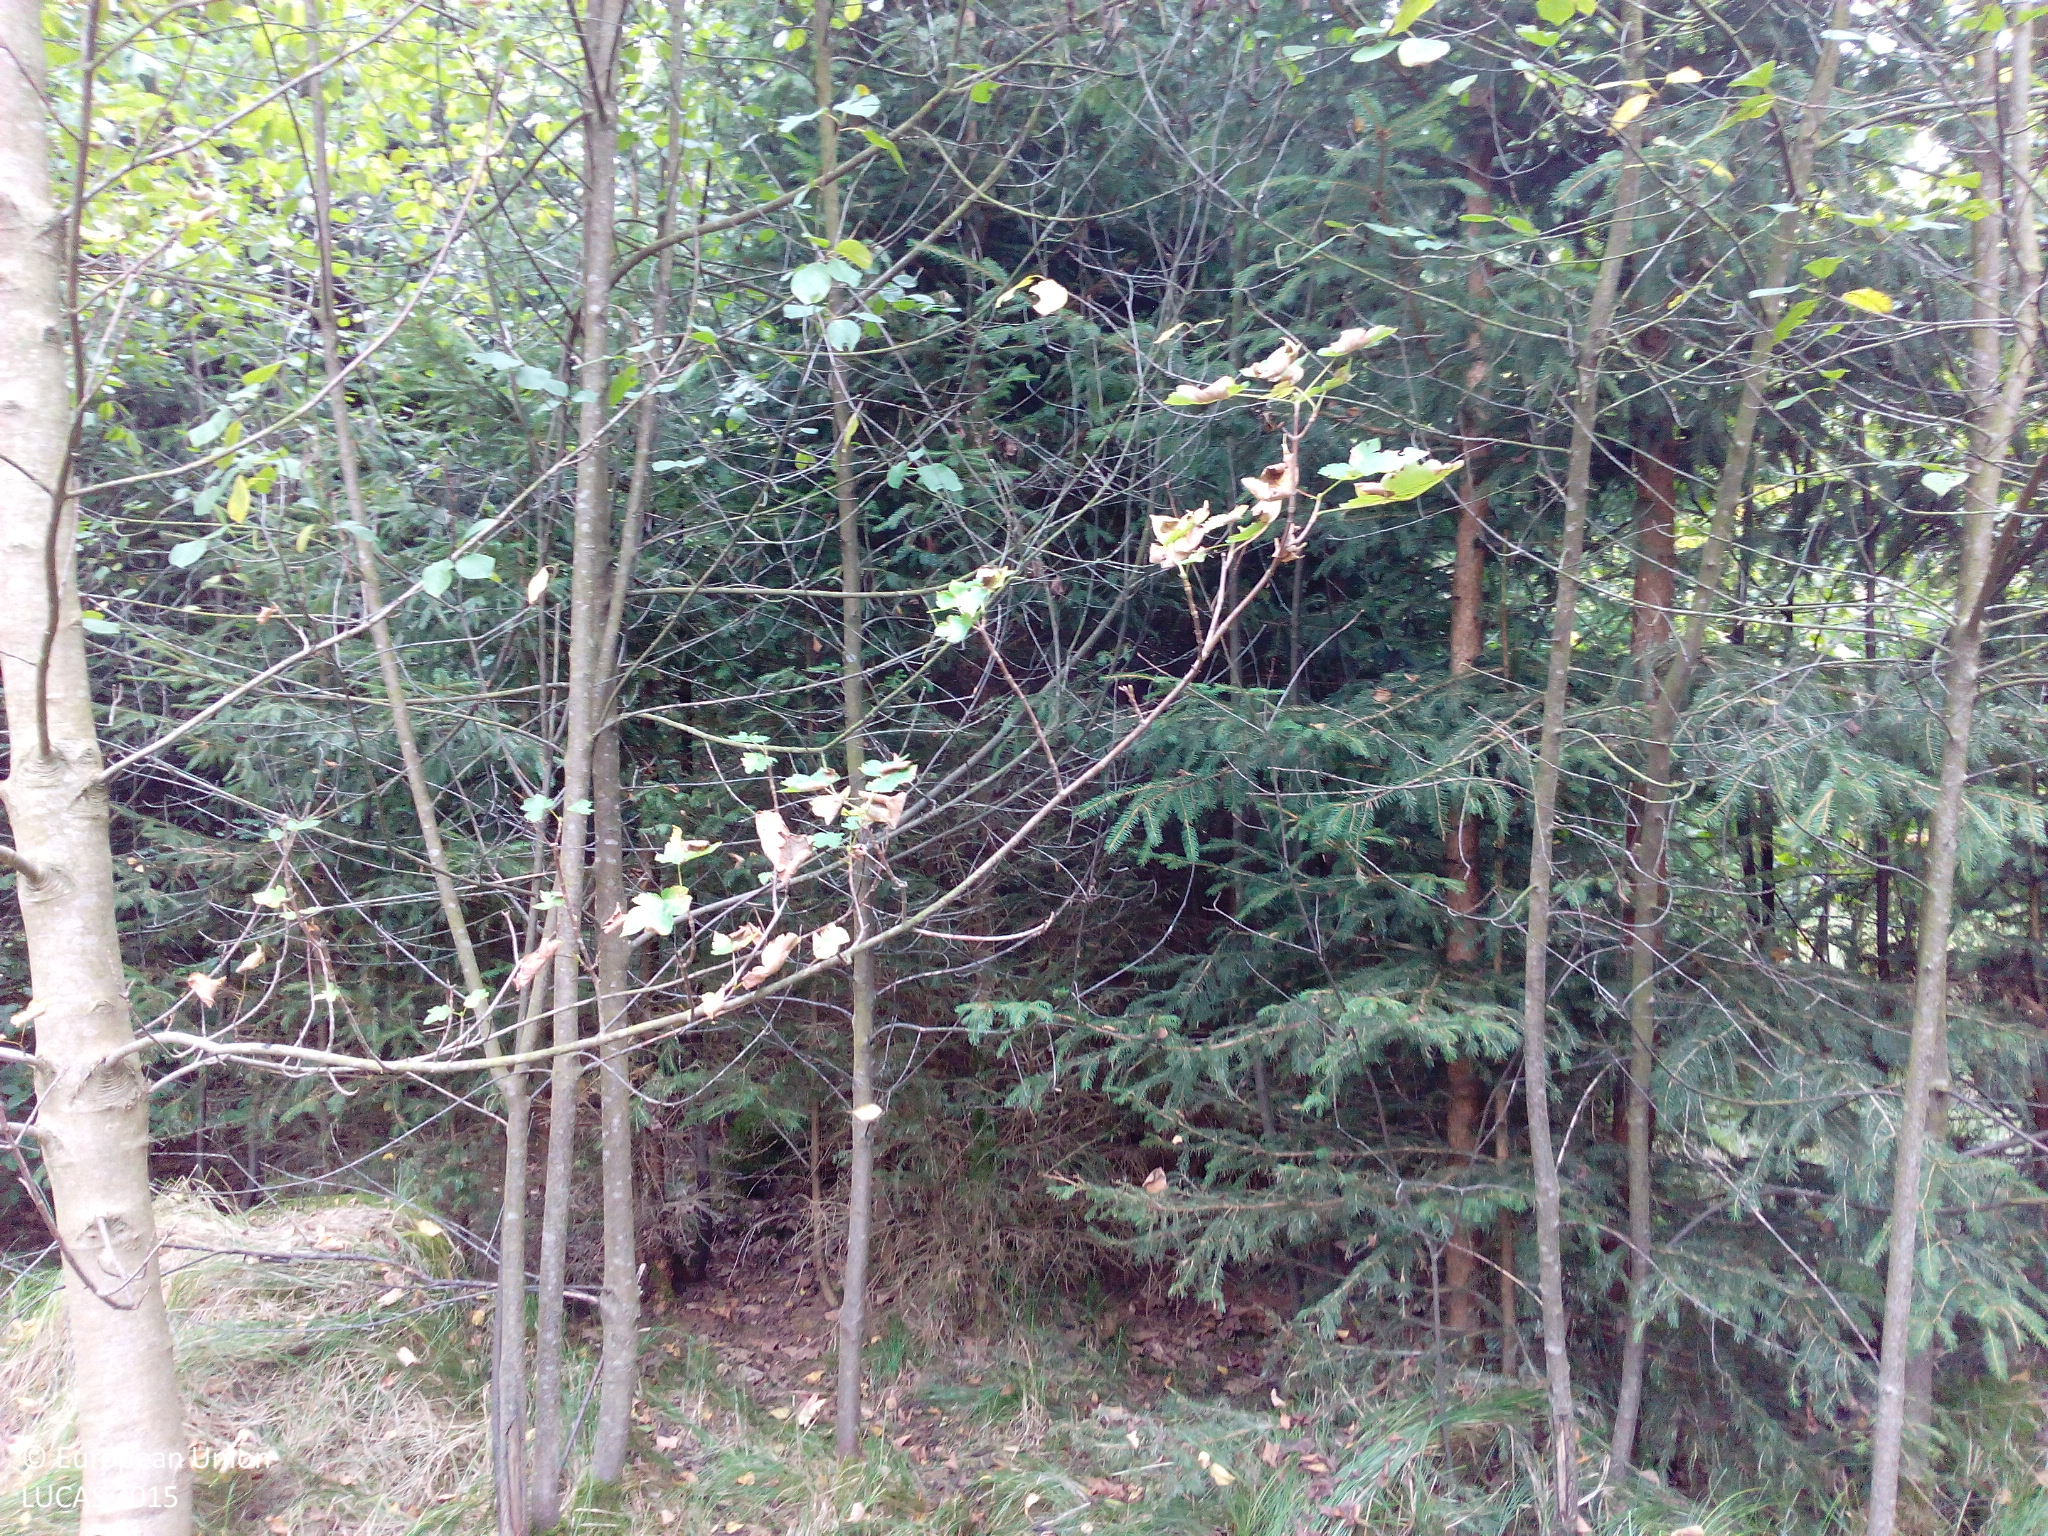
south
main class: Woodland
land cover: Broadleaved woodland
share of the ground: 50 - 75 %
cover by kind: broadleaved forest trees 60 %, herbaceous plants 40 %
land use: Forestry
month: September
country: DE
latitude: 48.3312
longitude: 10.2561
